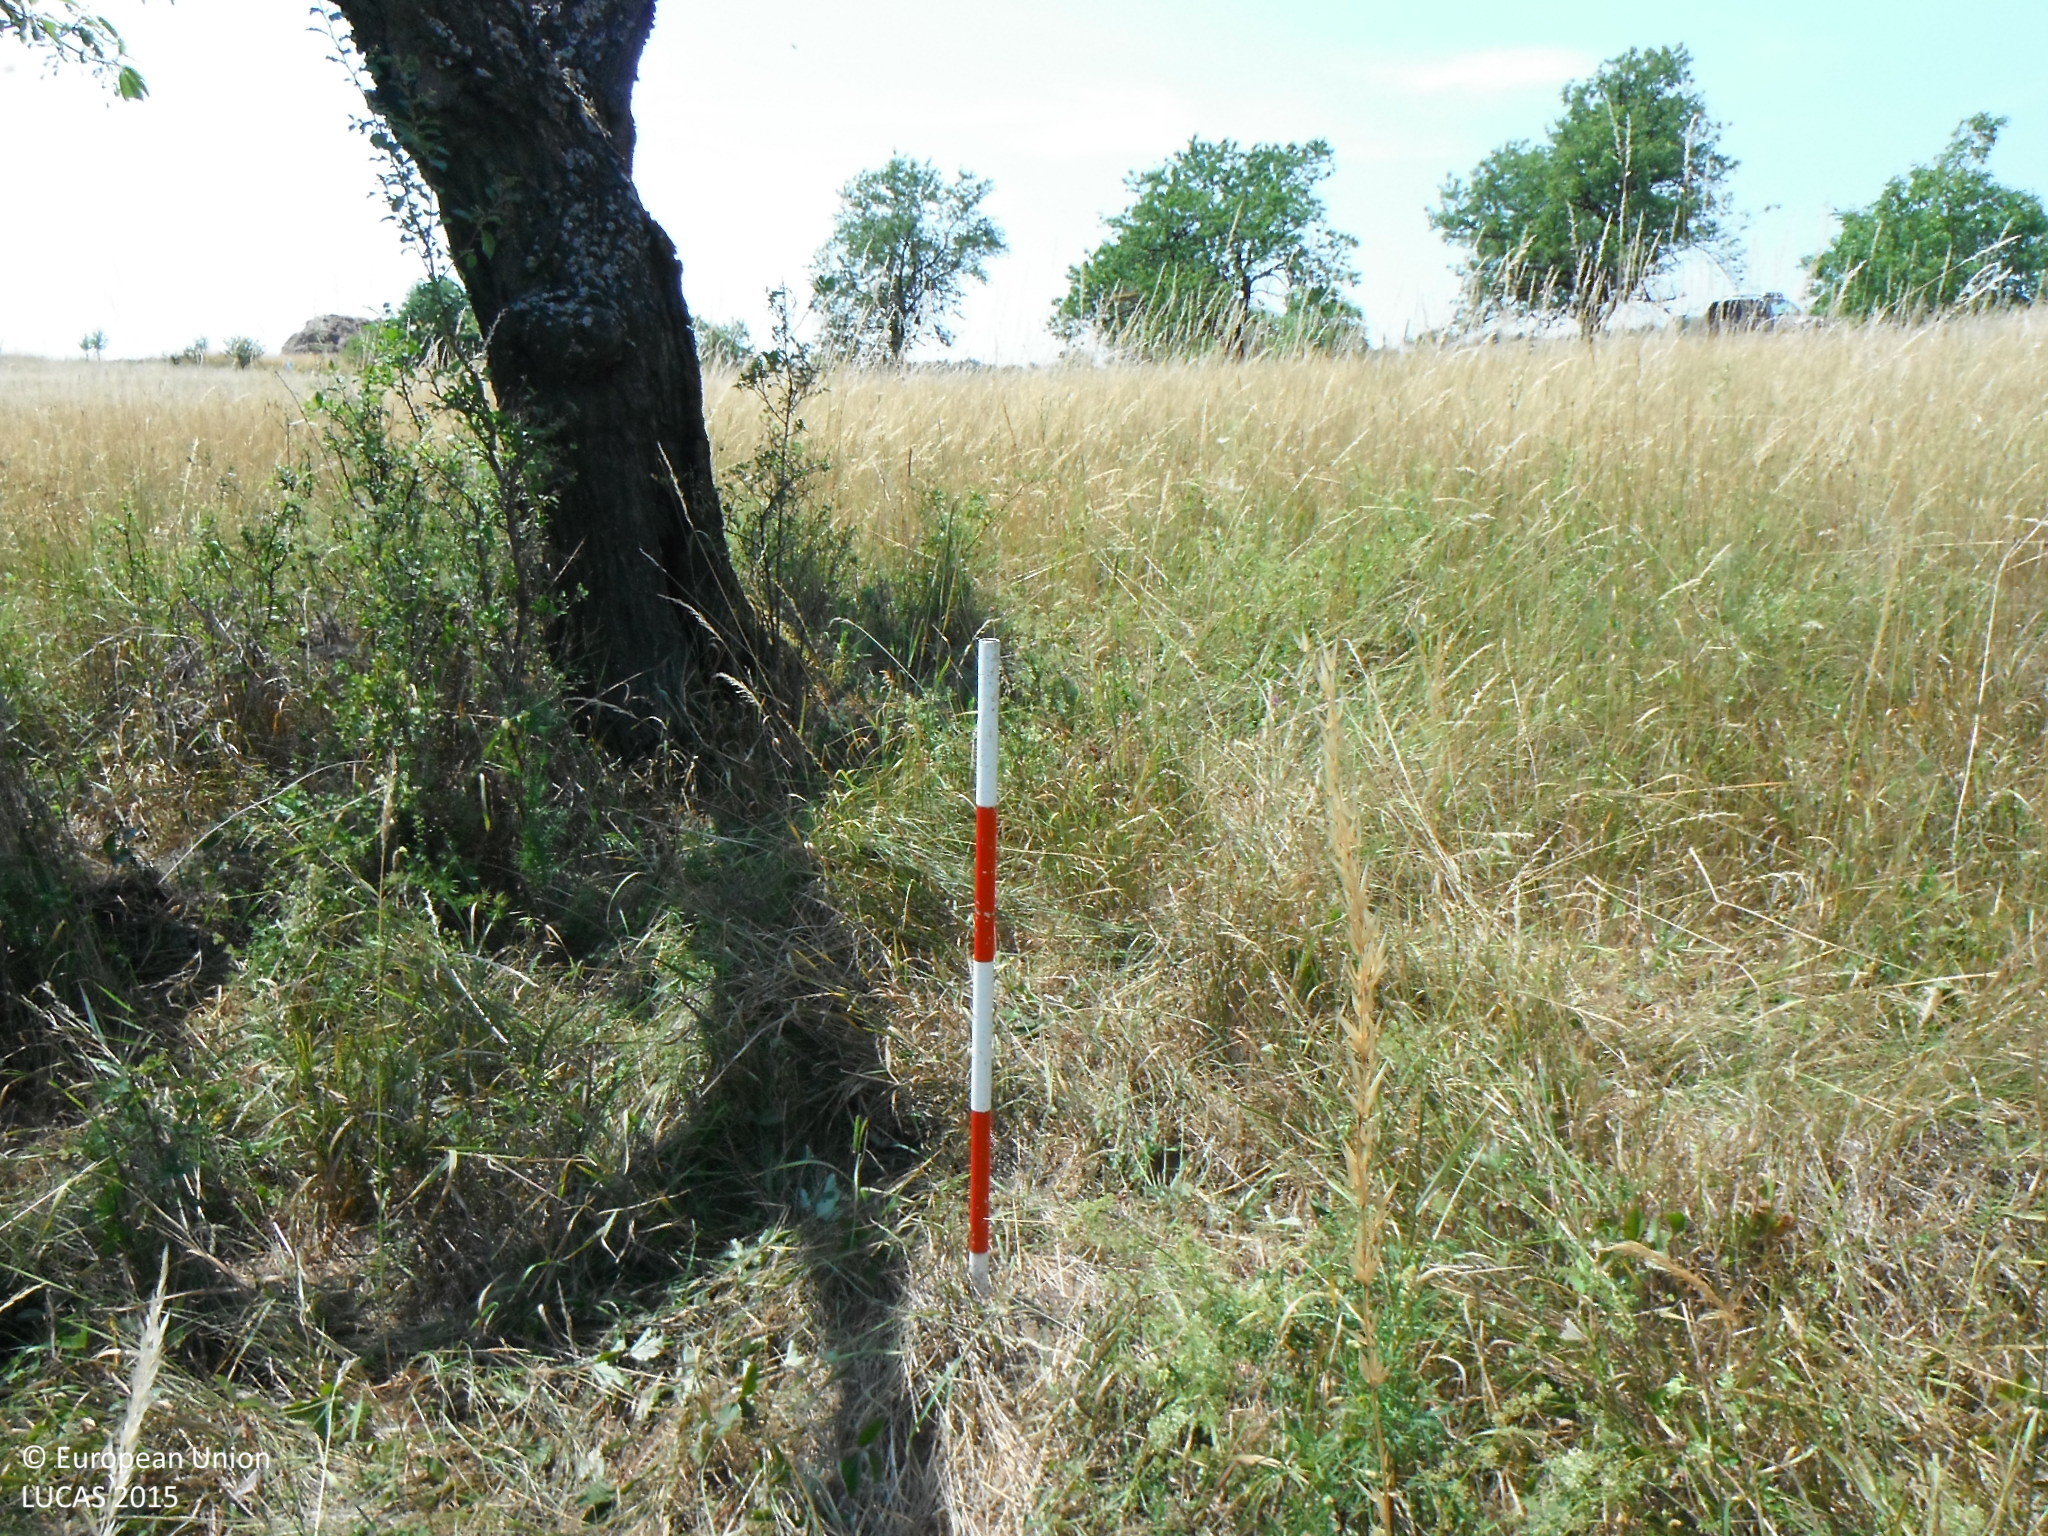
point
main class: Cropland
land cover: Cherry fruit
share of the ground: 10 - 25 %
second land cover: Grassland without tree/shrub cover
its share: > 75 %
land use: Agriculture (excluding fallow land and kitchen gardens)
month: July
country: SK
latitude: 48.1905
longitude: 19.1007
